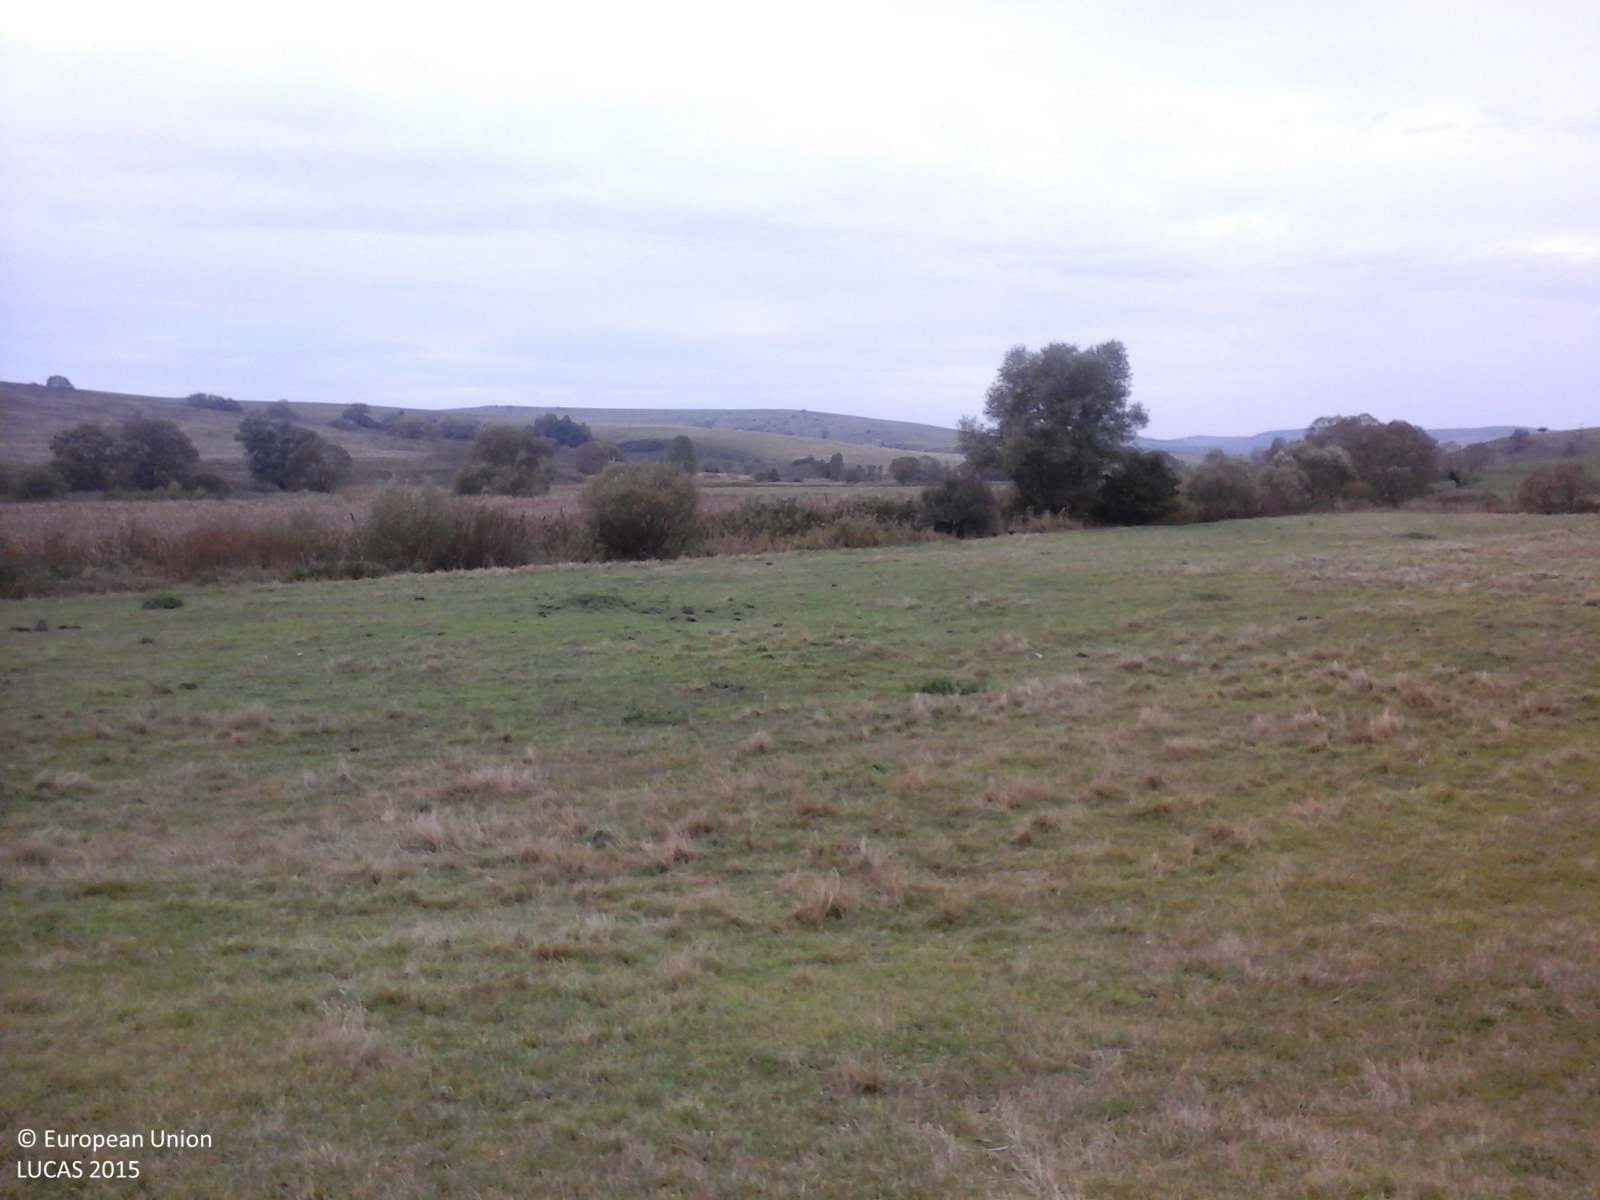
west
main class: Grassland
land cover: Grassland without tree/shrub cover
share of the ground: > 75 %
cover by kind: herbaceous plants 100 %
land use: Agriculture (excluding fallow land and kitchen gardens)
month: October
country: RO
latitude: 46.0309
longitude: 24.9108
